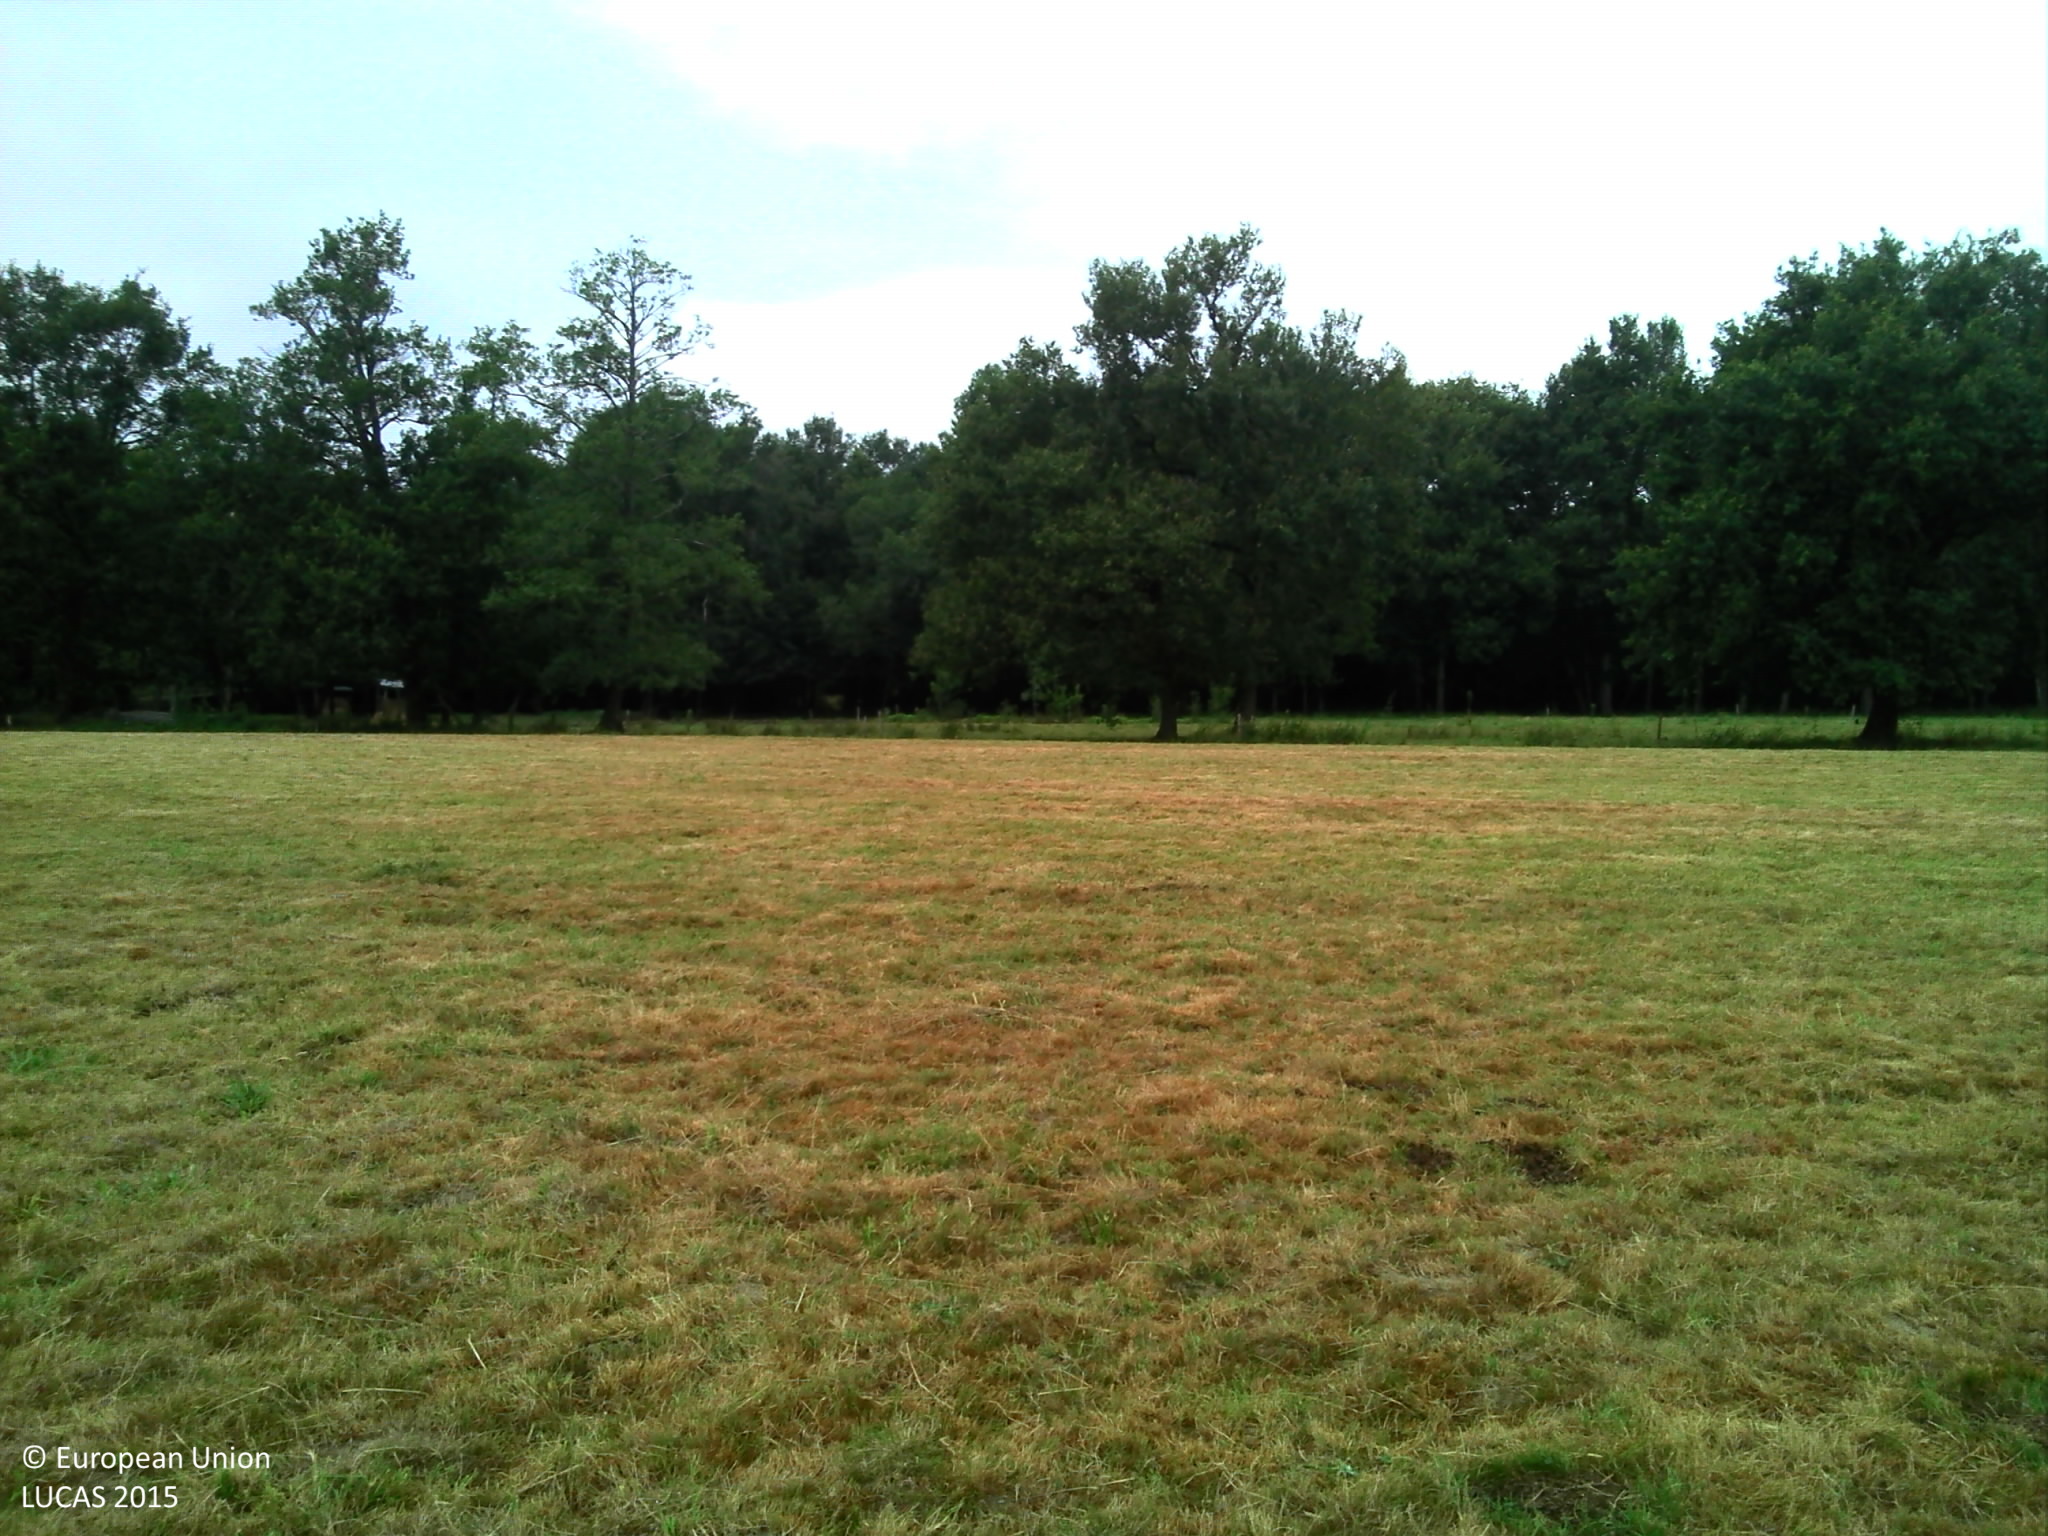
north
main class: Grassland
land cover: Grassland without tree/shrub cover
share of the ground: > 75 %
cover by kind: herbaceous plants 100 %
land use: Agriculture (excluding fallow land and kitchen gardens)
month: July
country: FR
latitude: 43.6116
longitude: -1.2299
